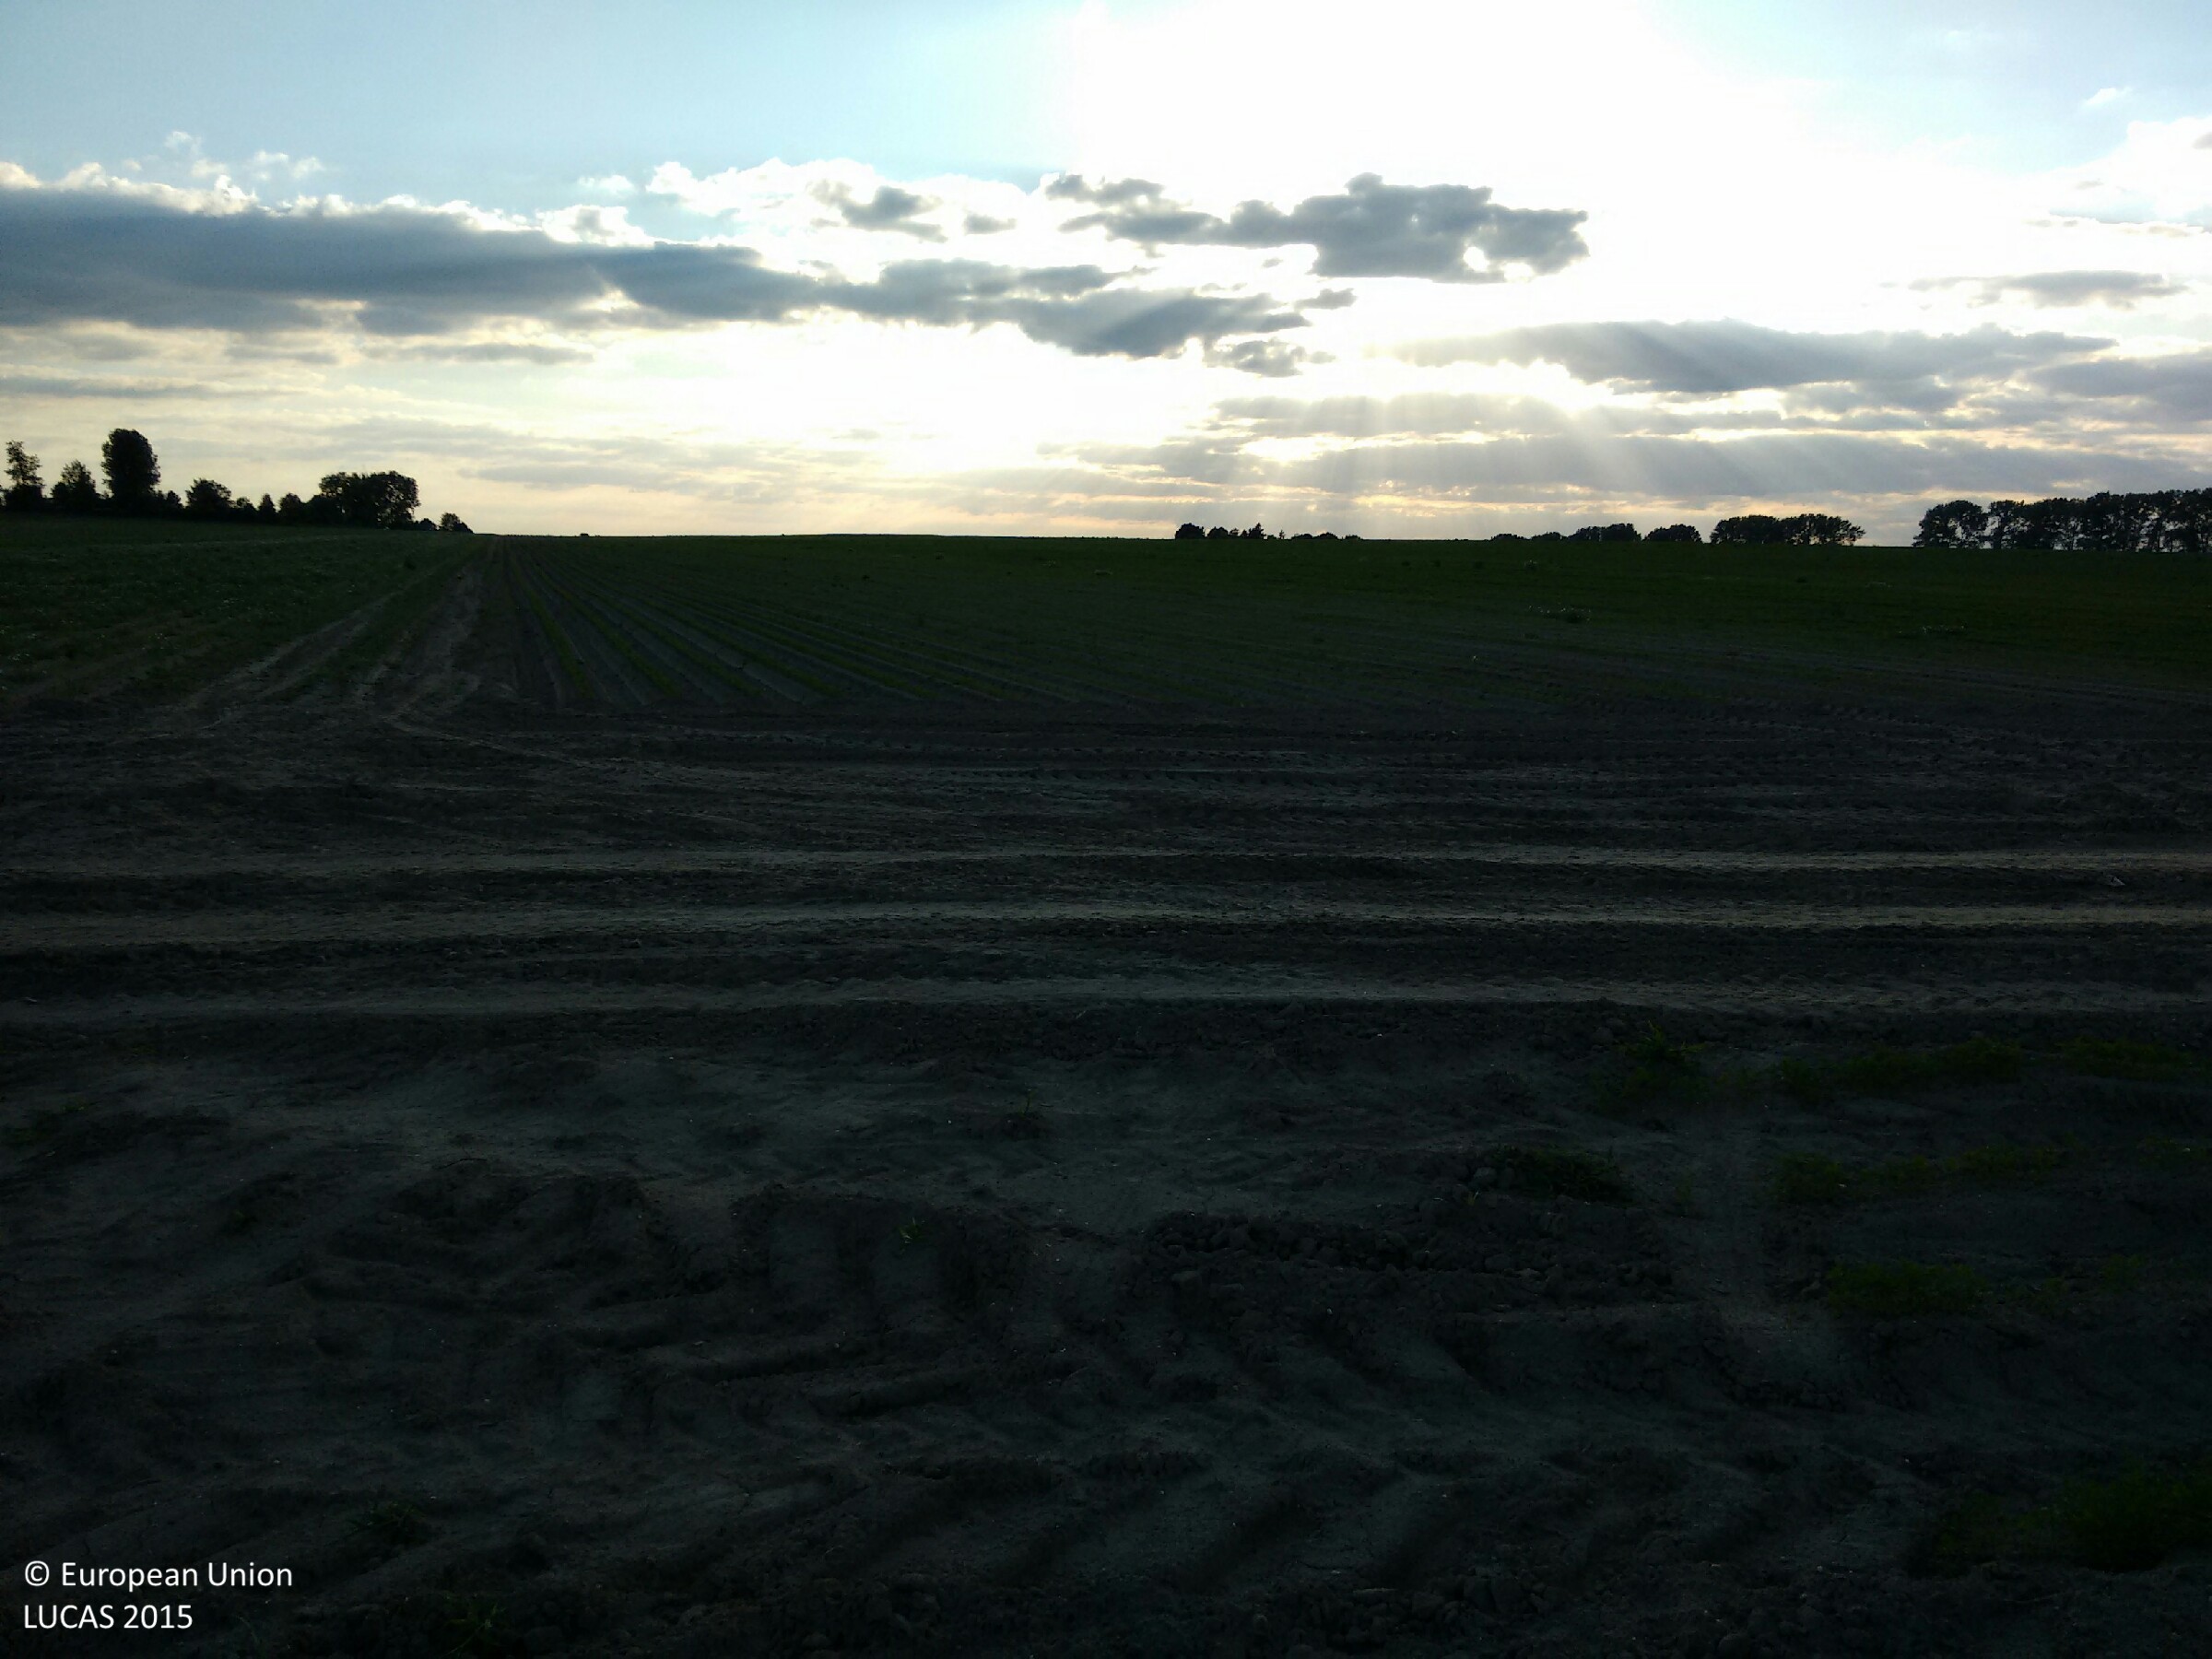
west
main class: Cropland
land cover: Other root crops
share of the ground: 10 - 25 %
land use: Agriculture (excluding fallow land and kitchen gardens)
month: June
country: PL
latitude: 50.4338
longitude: 18.6505
